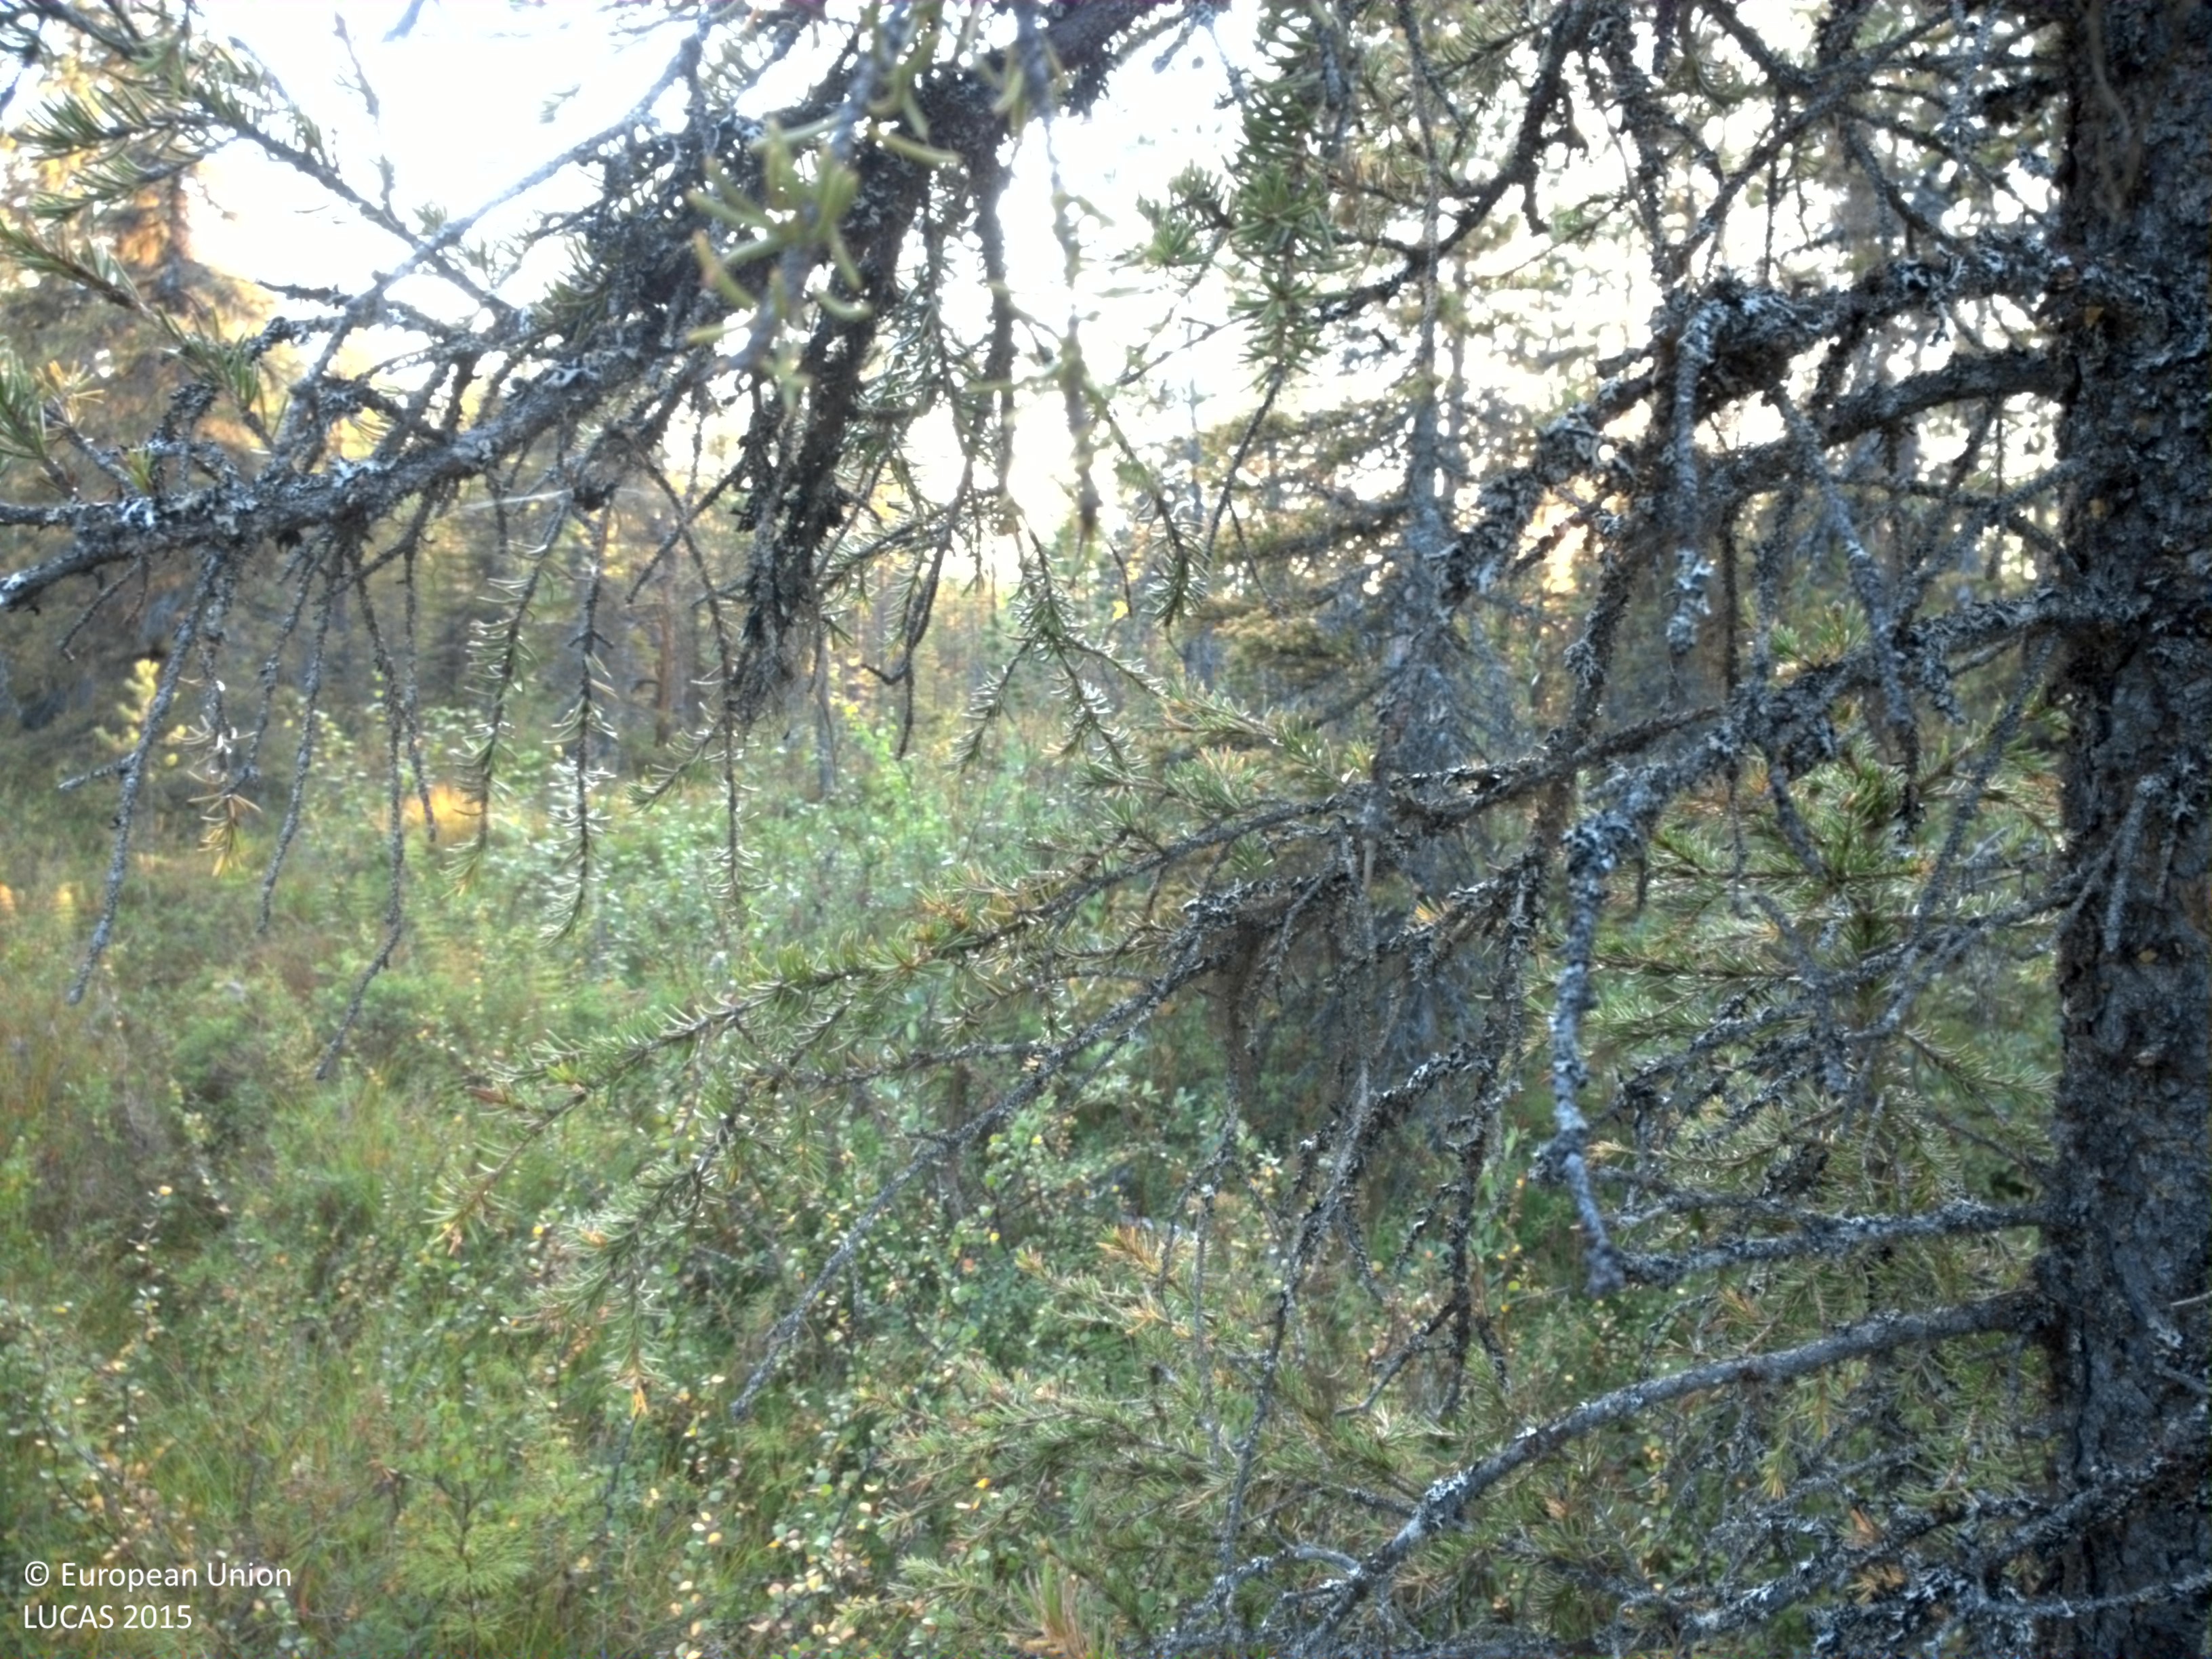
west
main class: Woodland
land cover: Spruce dominated coniferous woodland
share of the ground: 25 - 50 %
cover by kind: shrubs 70 %, coniferous forest trees 30 %
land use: Forestry
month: August
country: SE
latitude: 66.7285
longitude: 19.9996
